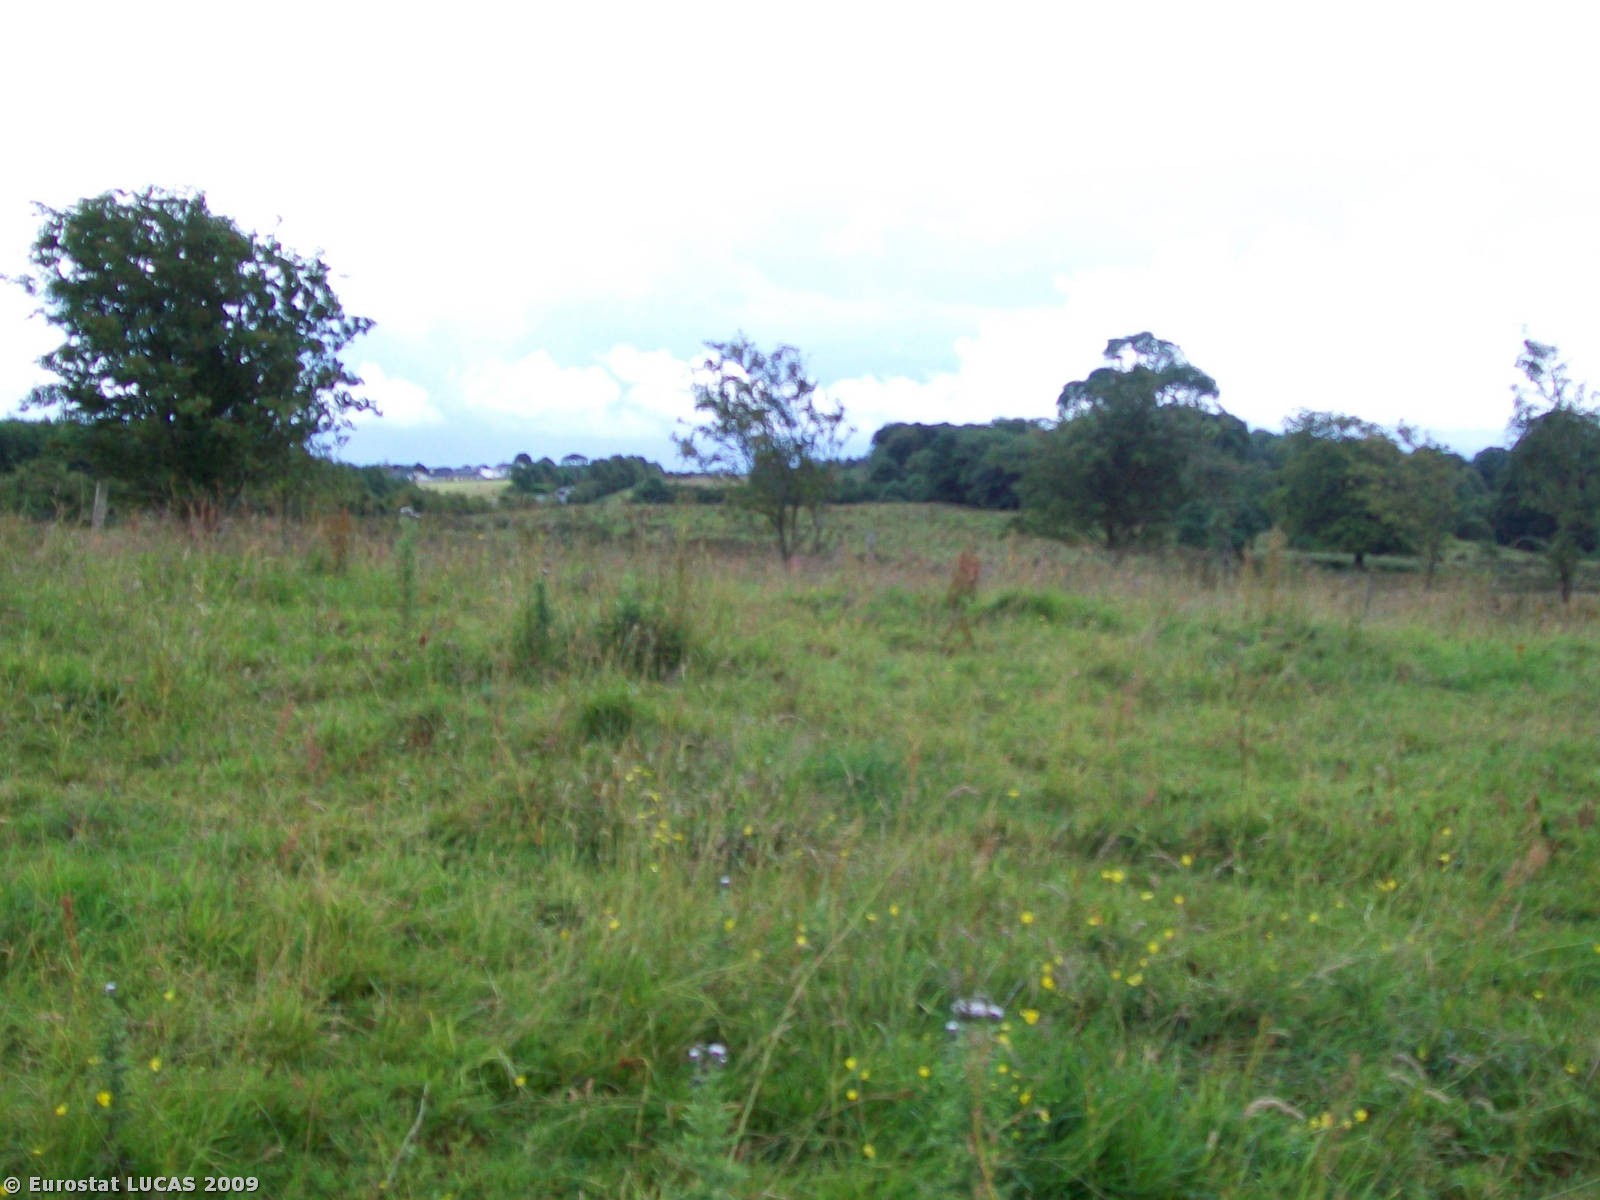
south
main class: Grassland
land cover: Grassland without tree/shrub cover
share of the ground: > 75 %
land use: Agriculture (excluding fallow land and kitchen gardens)
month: July
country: IE
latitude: 53.6945
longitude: -8.9757
